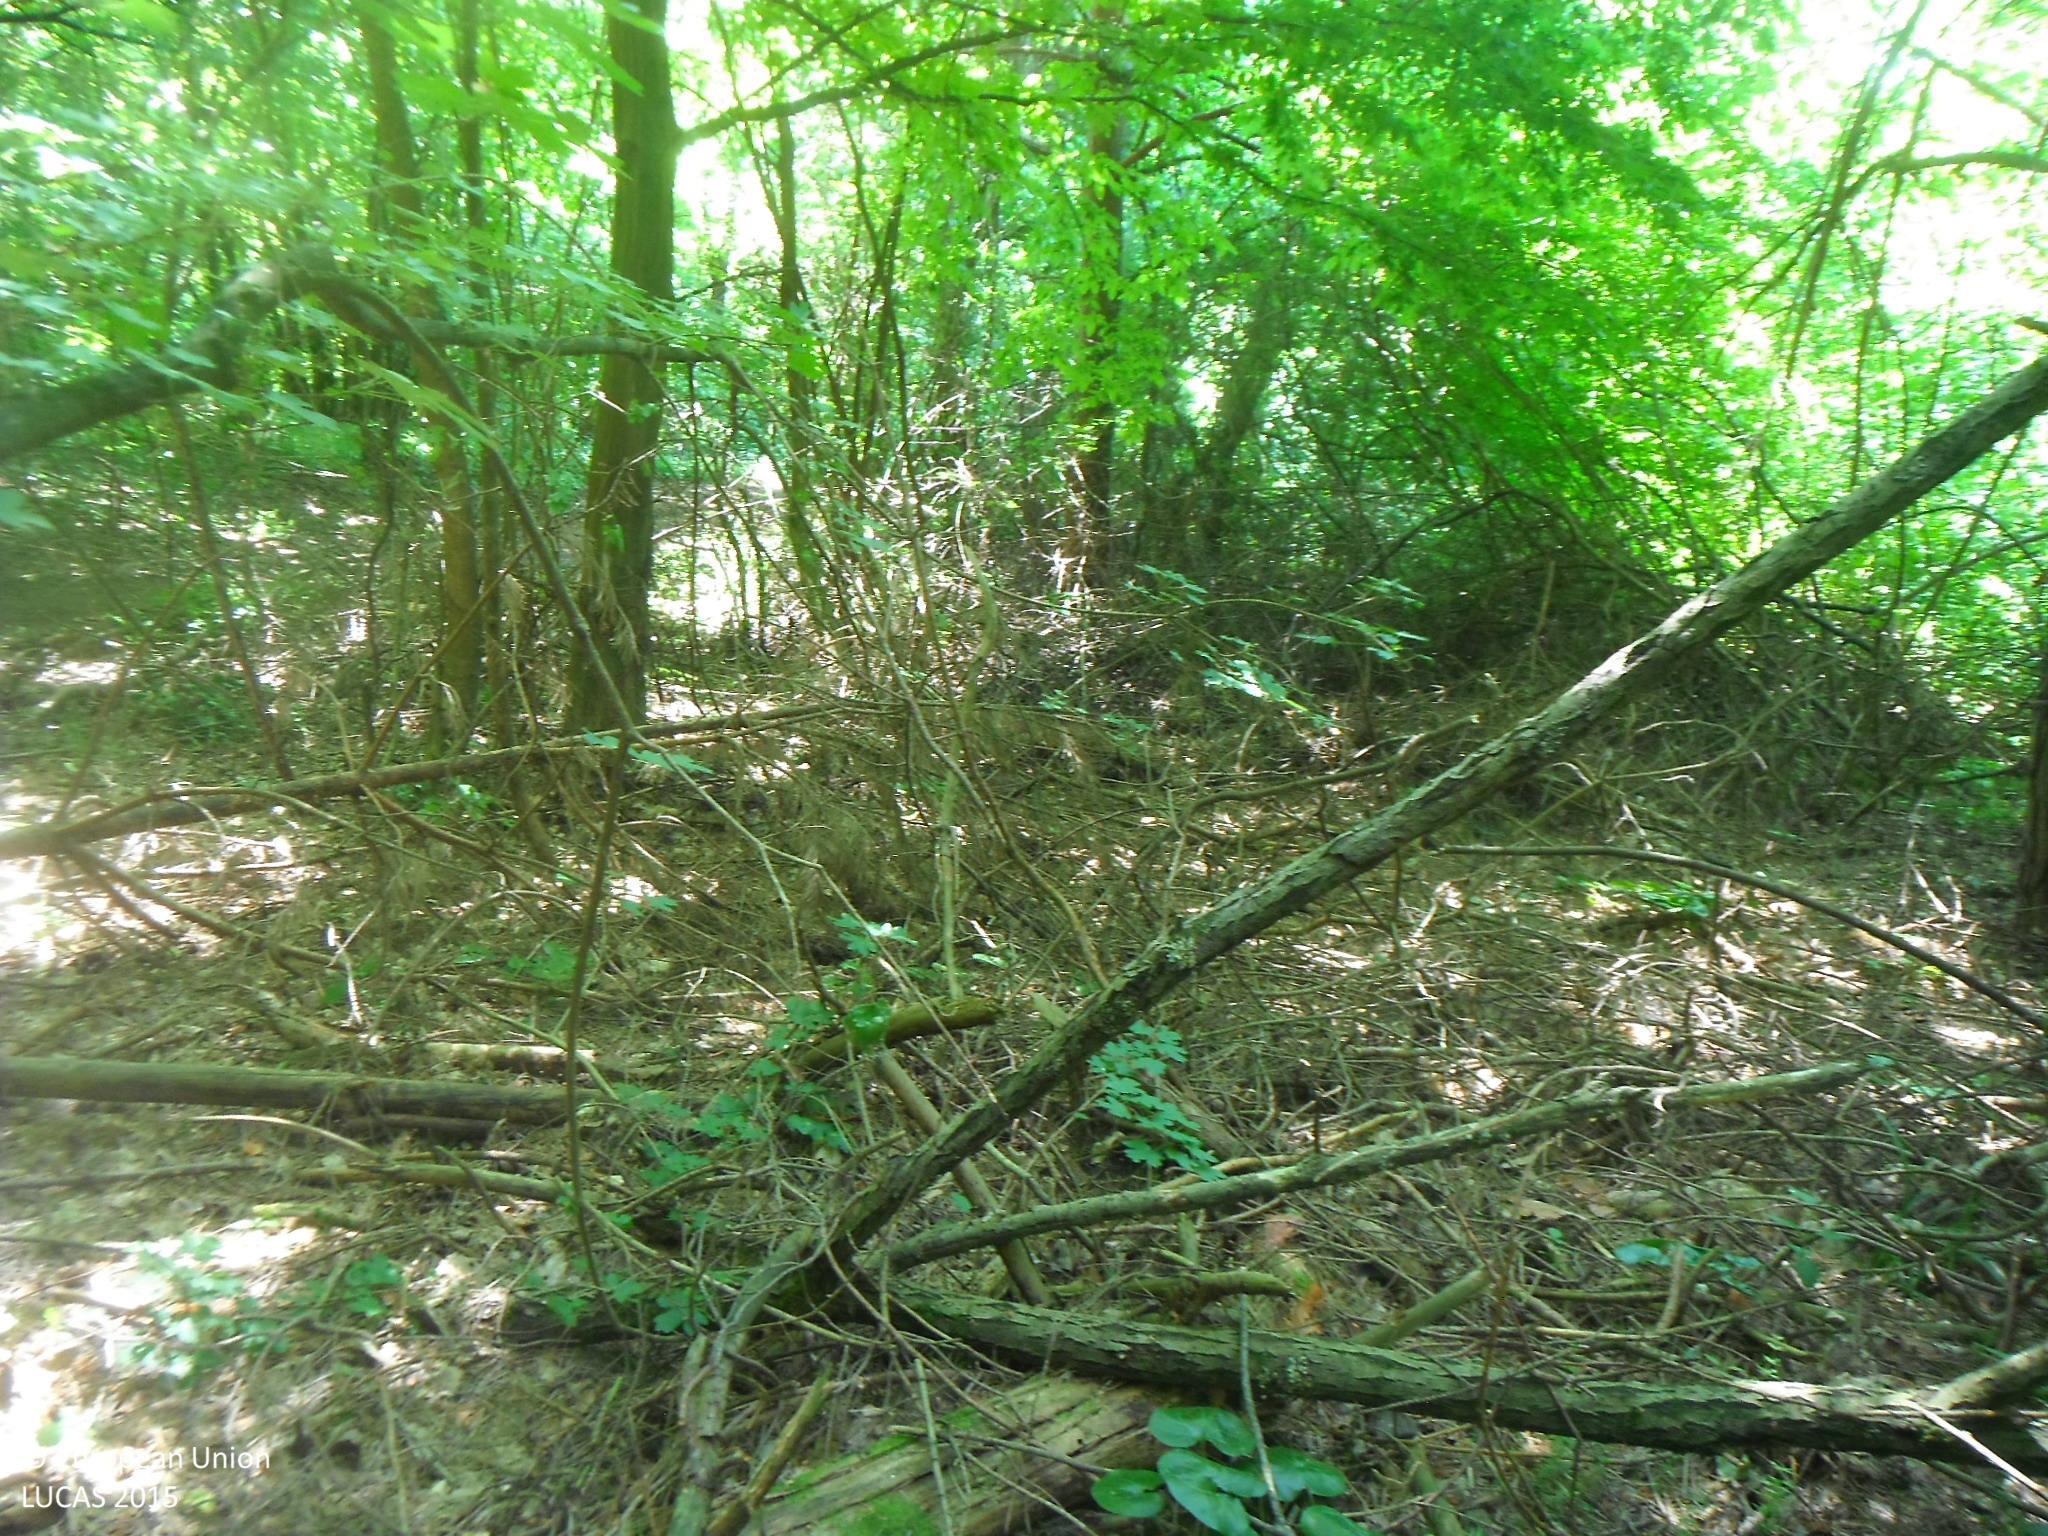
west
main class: Woodland
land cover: Pine dominated mixed woodland
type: beech forest
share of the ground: > 75 %
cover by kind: broadleaved forest trees 70 %, coniferous forest trees 30 %
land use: Forestry
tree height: > 5 m
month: June
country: SK
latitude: 49.0081
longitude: 21.6019
